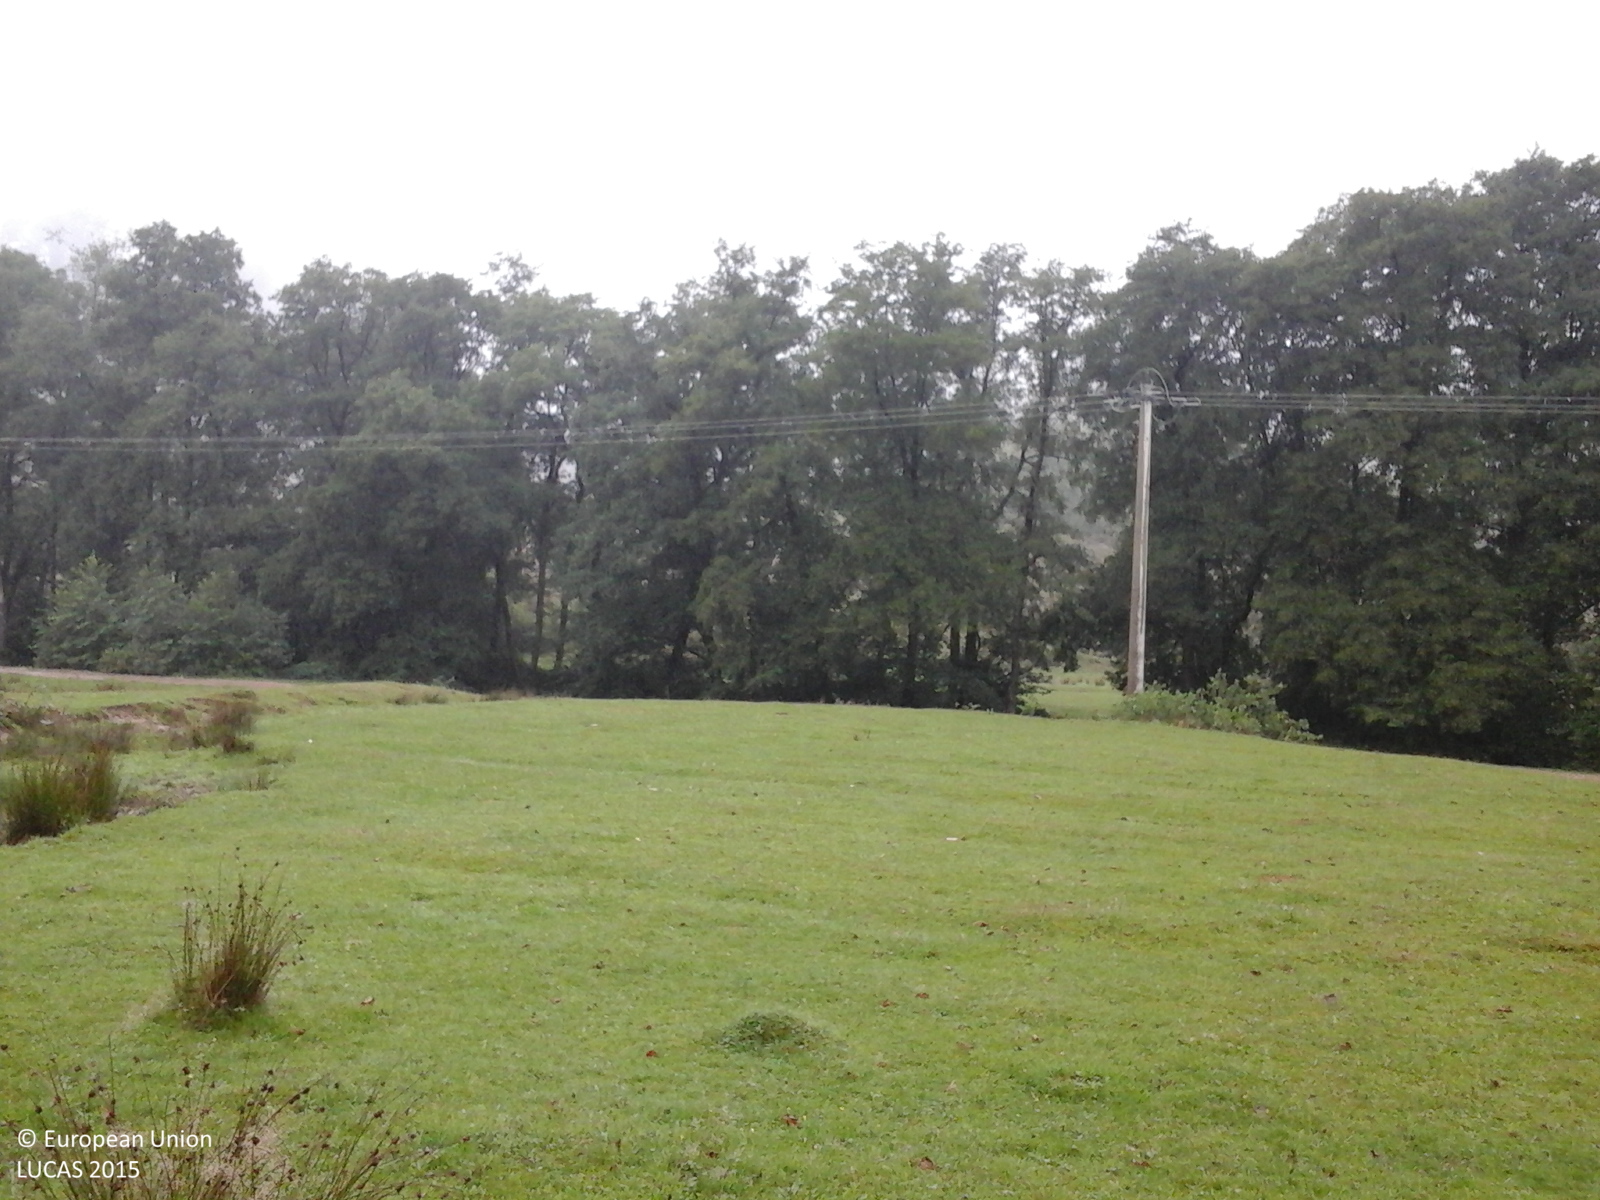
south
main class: Grassland
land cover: Grassland without tree/shrub cover
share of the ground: > 75 %
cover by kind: herbaceous plants 100 %
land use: Agriculture (excluding fallow land and kitchen gardens)
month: September
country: RO
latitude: 46.9481
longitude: 22.3093
